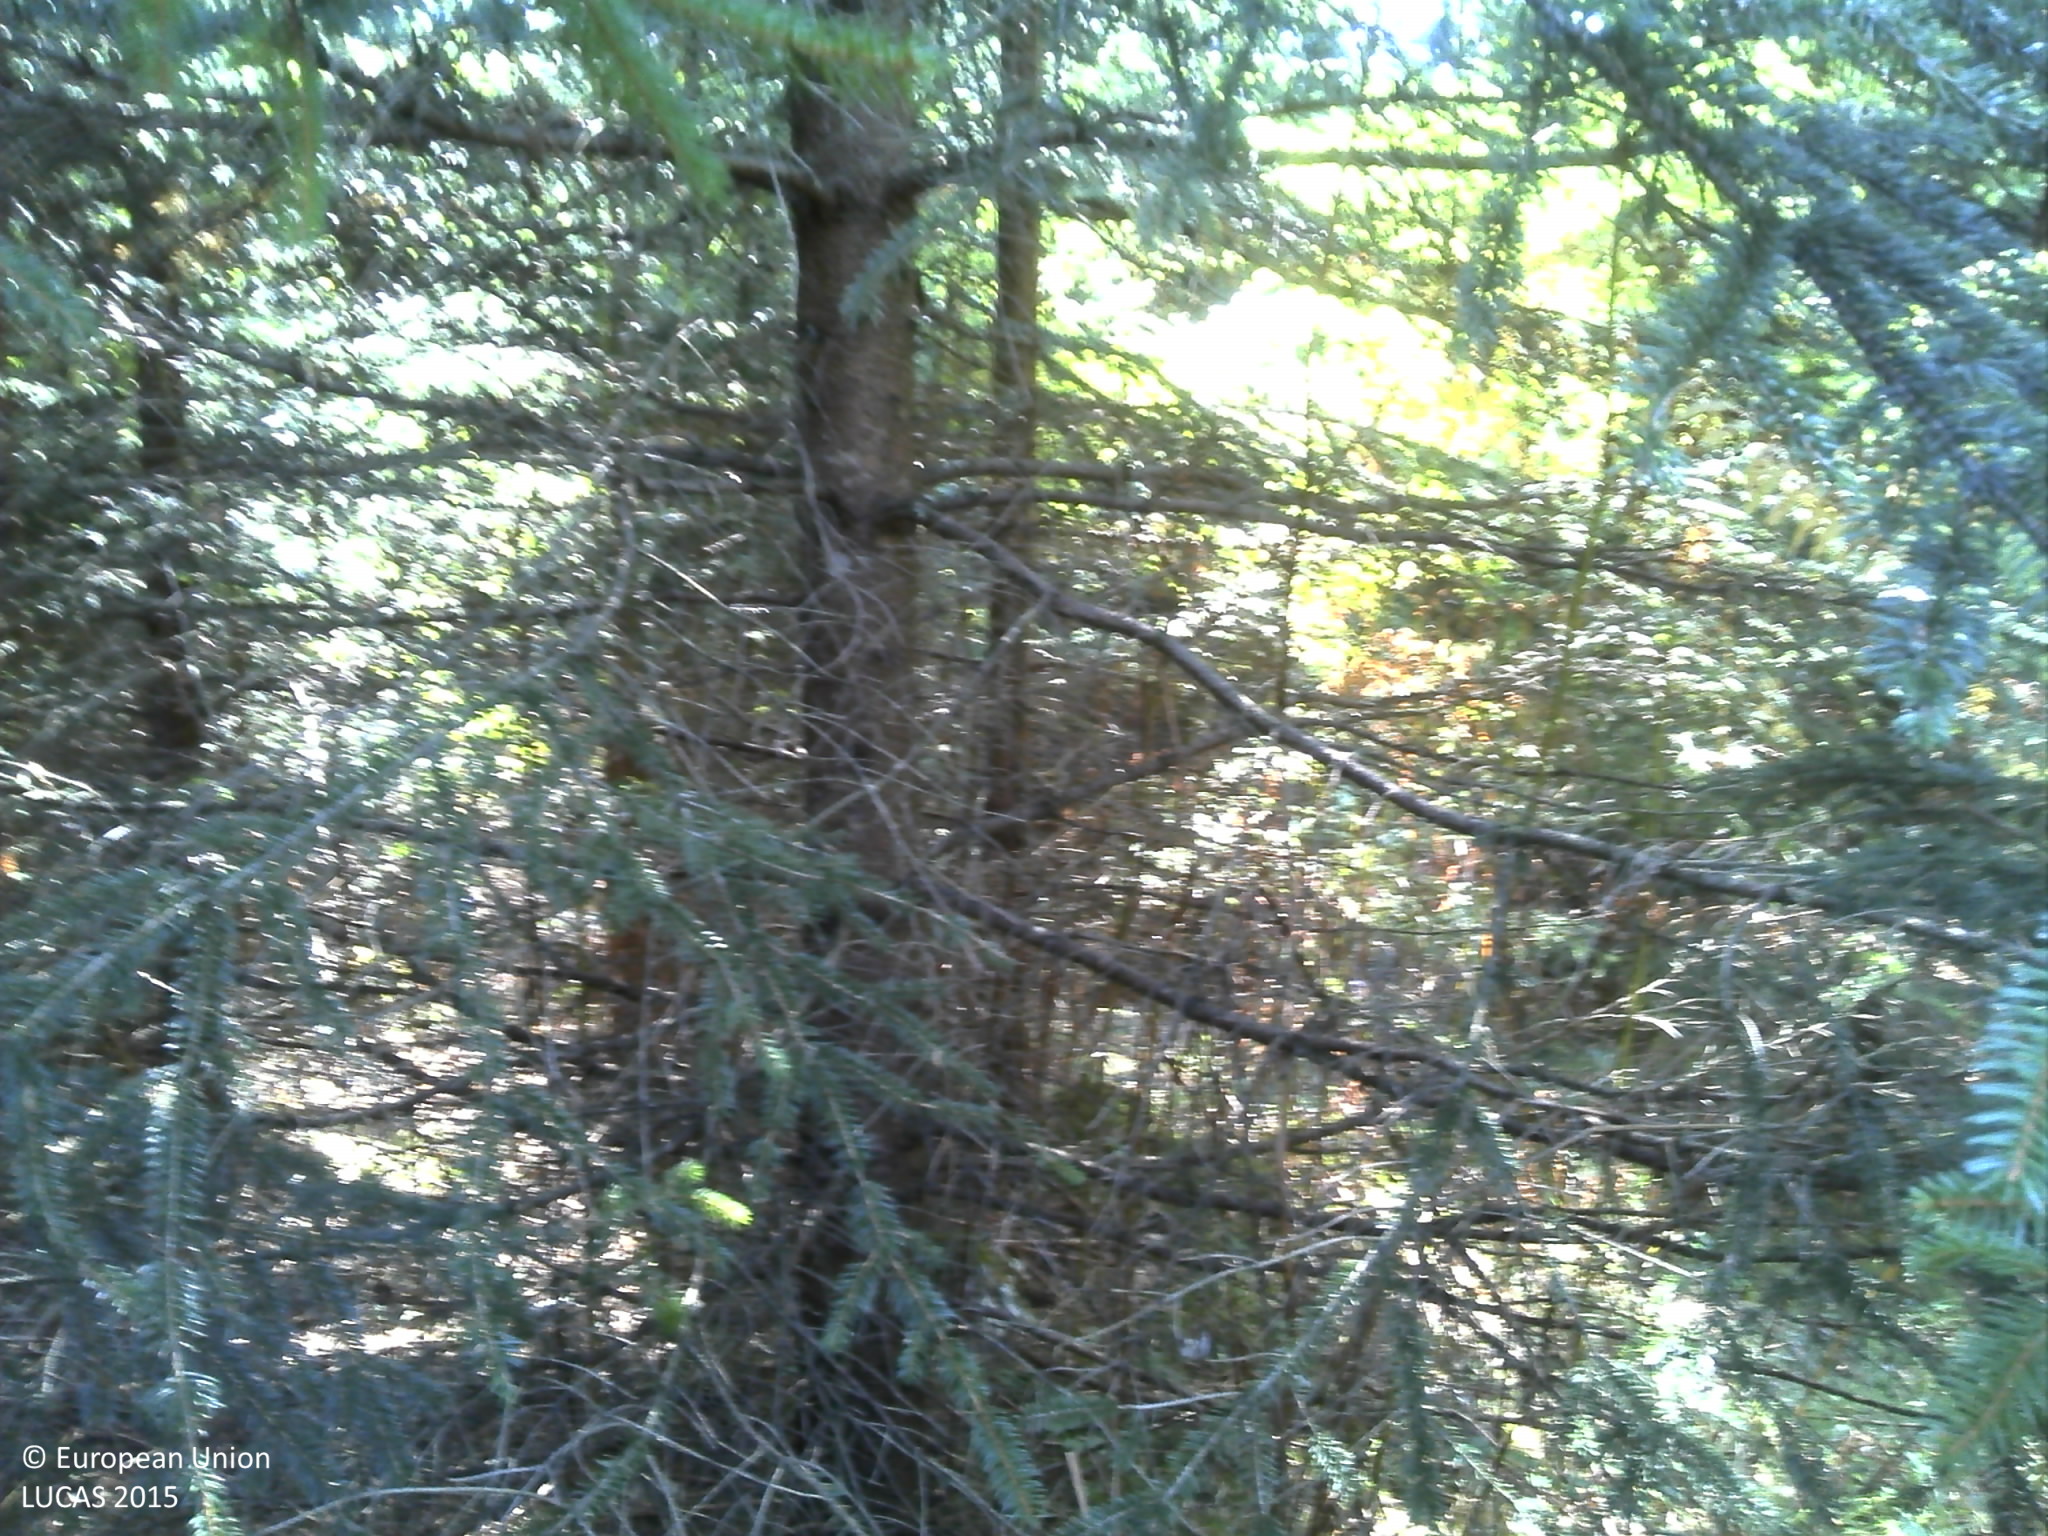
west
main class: Woodland
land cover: Spruce dominated coniferous woodland
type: coniferous forest of the mediterranean region
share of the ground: > 75 %
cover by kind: coniferous forest trees 100 %
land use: Forestry
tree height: > 5 m
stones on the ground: < 10 %
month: September
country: HR
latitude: 45.3177
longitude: 15.2894
